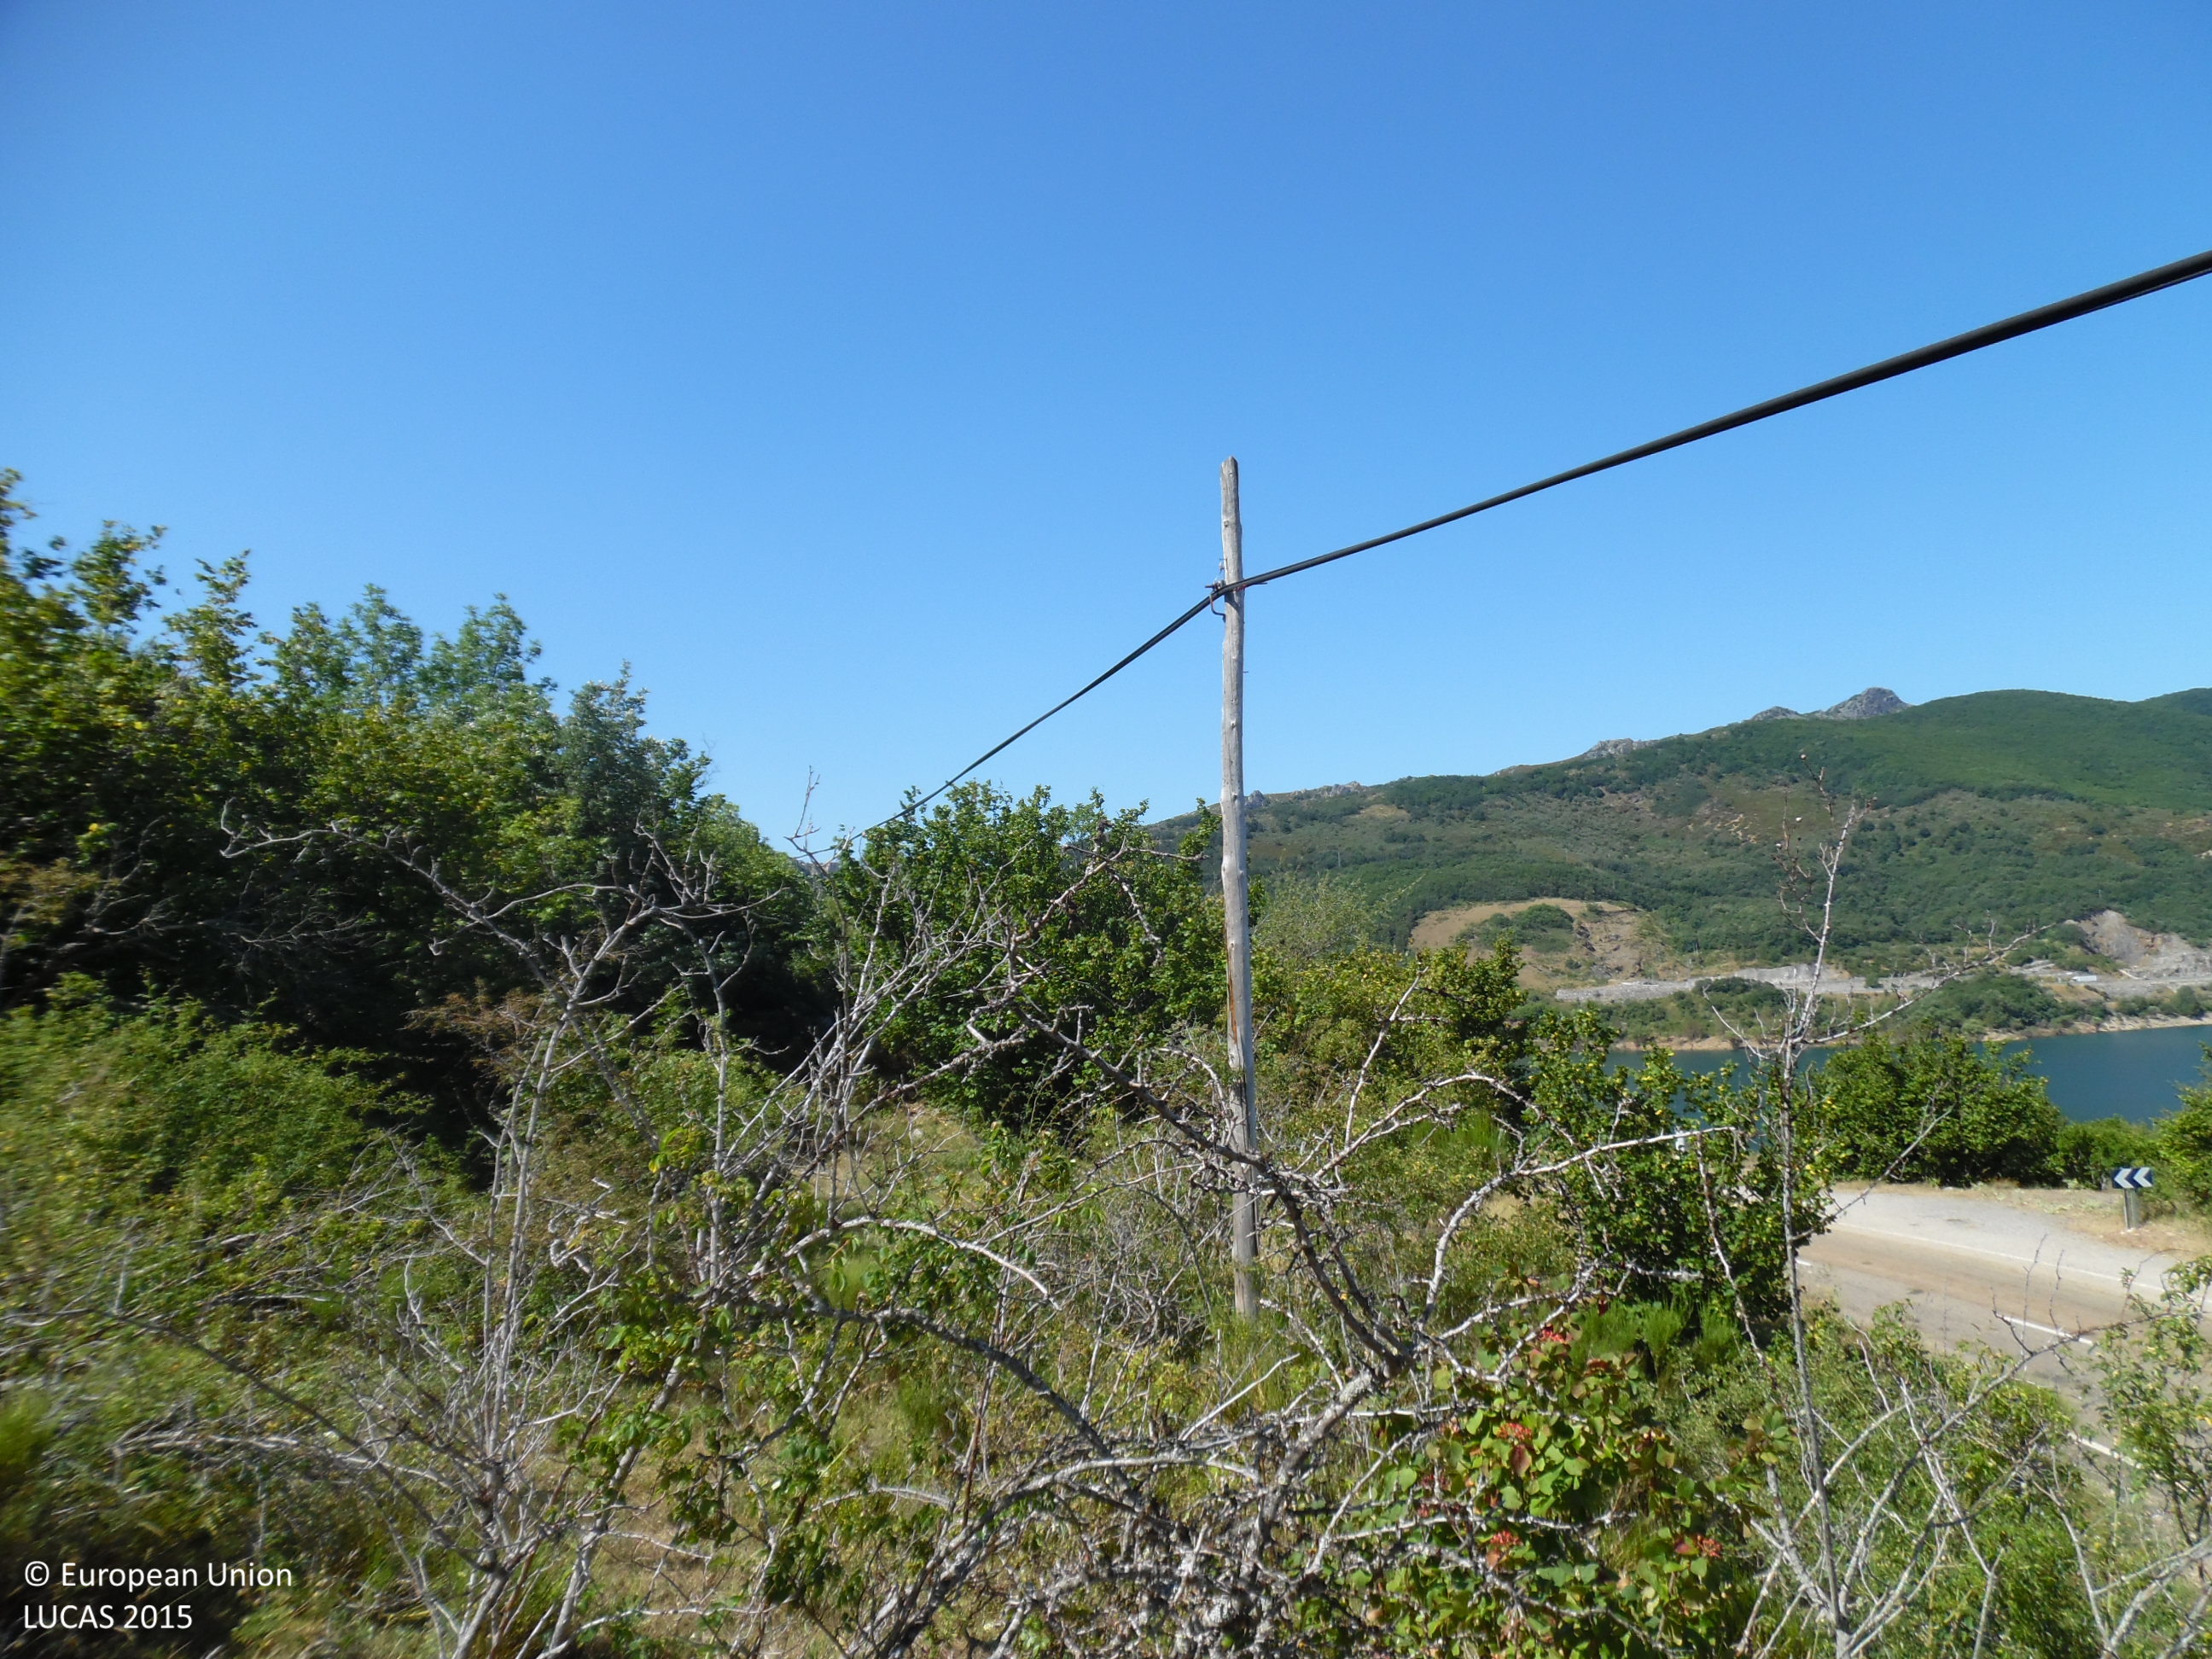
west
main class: Woodland
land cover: Broadleaved woodland
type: mountainous beech forest
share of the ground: > 75 %
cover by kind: broadleaved forest trees 90 %, shrubs 5 %, herbaceous plants 5 %
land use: Forestry
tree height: > 5 m
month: July
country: ES
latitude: 42.8645
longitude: -5.8593
